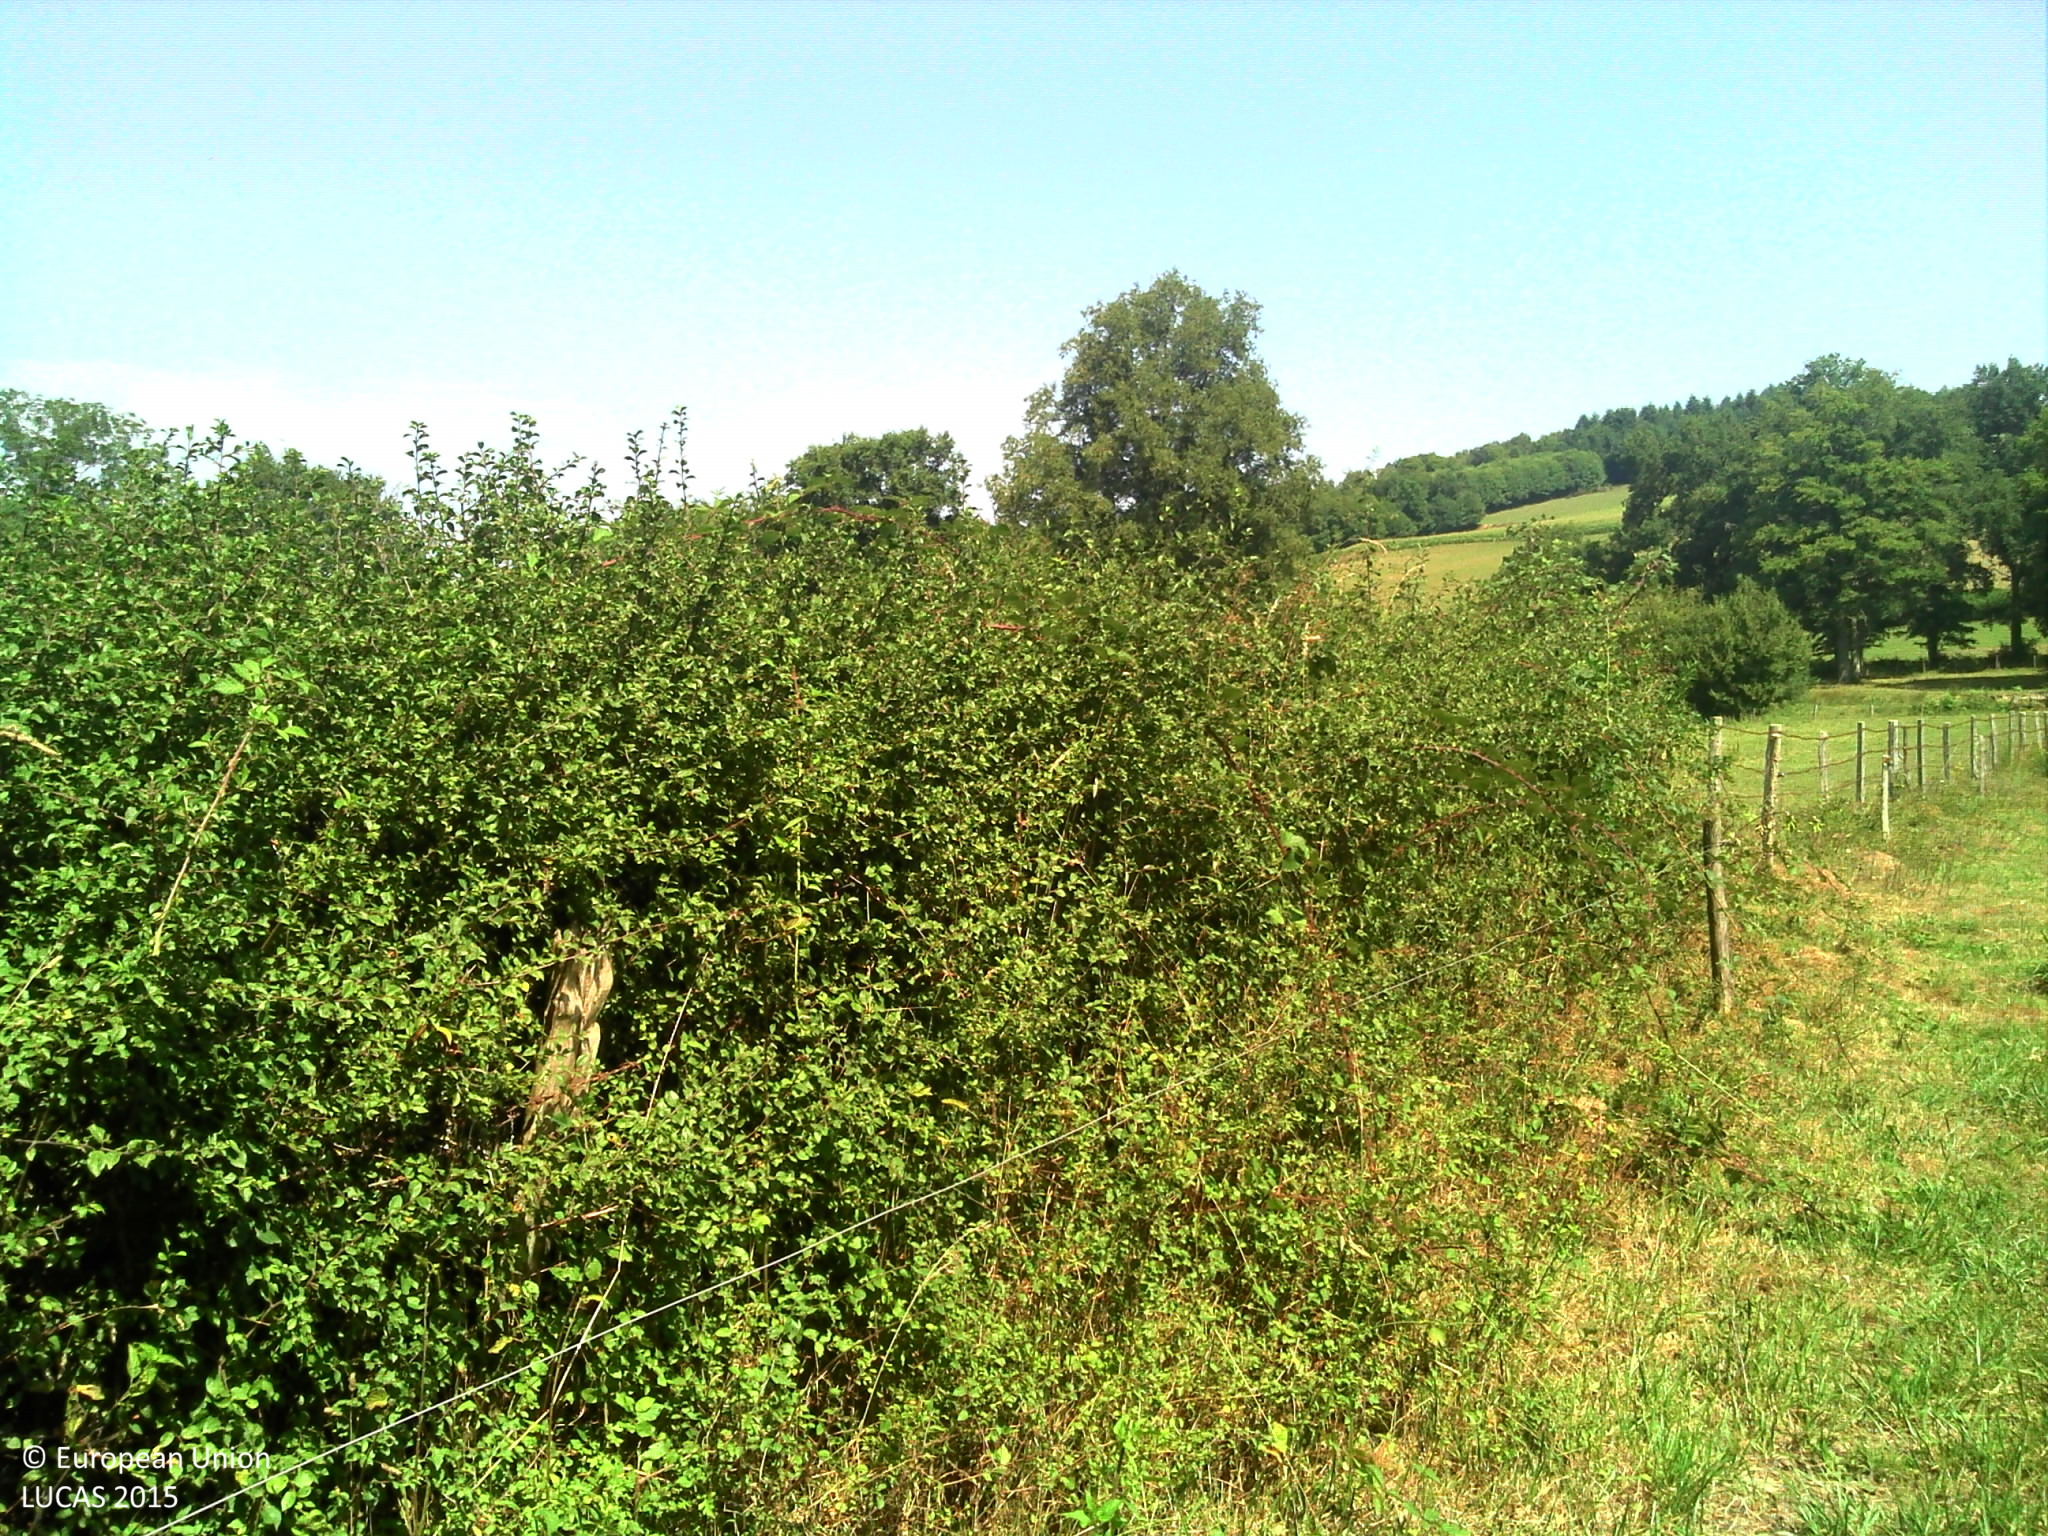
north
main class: Grassland
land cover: Grassland without tree/shrub cover
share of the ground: > 75 %
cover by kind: herbaceous plants 100 %
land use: Agriculture (excluding fallow land and kitchen gardens)
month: August
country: FR
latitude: 46.2596
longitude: 1.6497
